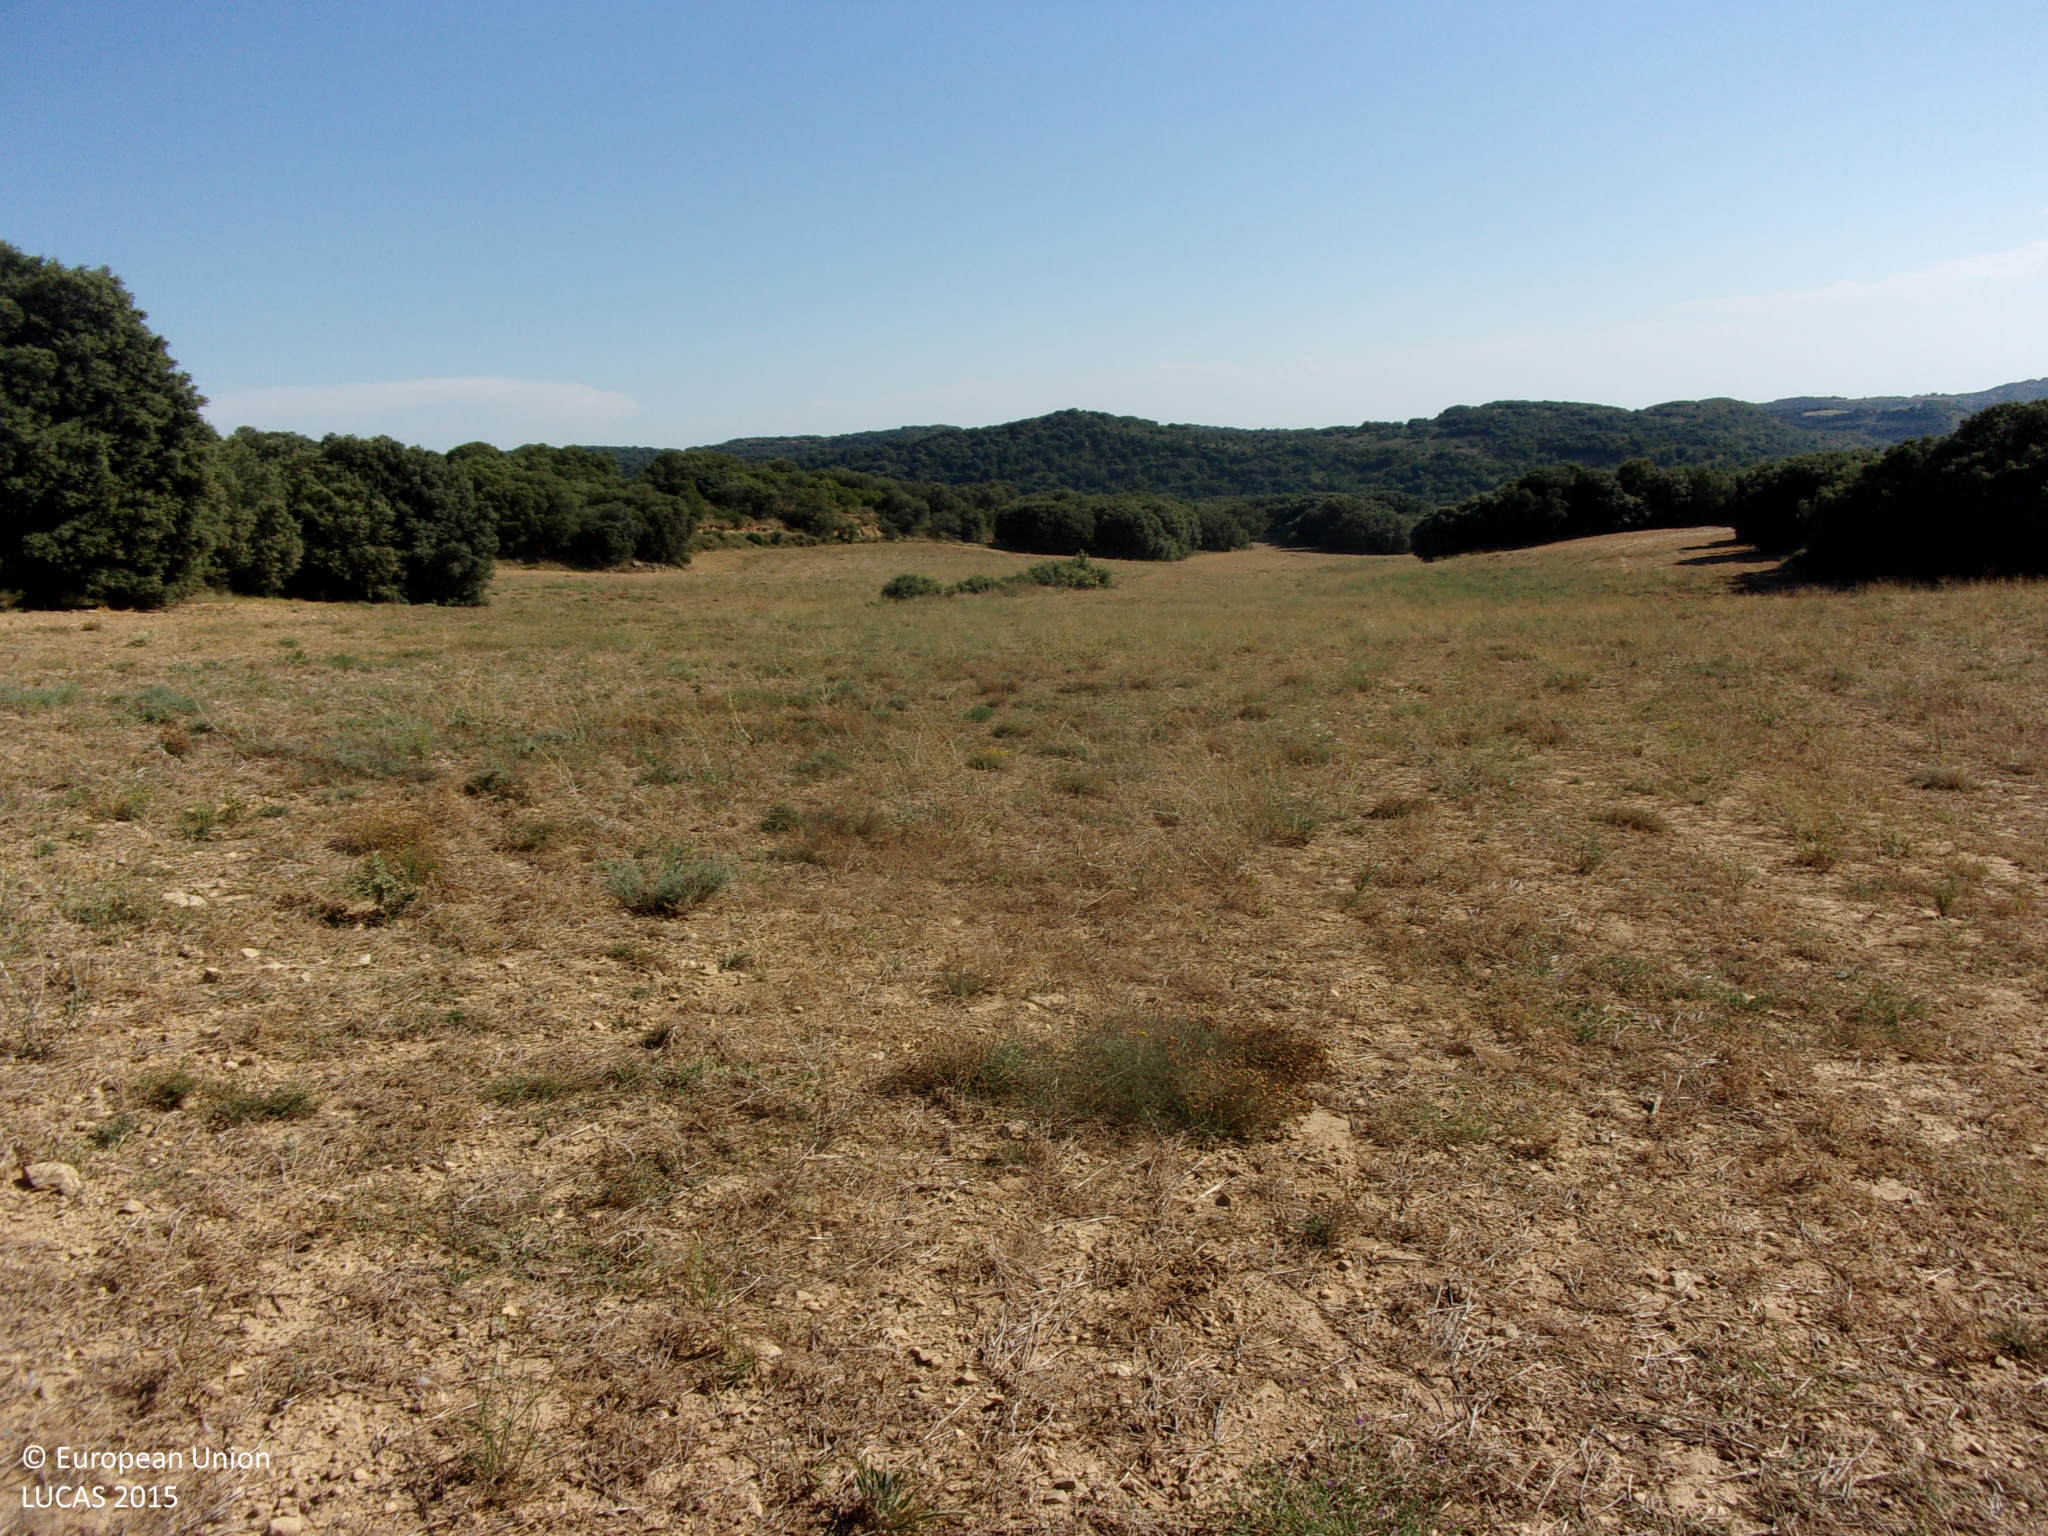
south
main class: Grassland
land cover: Spontaneously vegetated surfaces
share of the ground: 50 - 75 %
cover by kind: herbaceous plants 75 %, unconsolidated bare surface 25 %
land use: Fallow land
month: August
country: ES
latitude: 42.3349
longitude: -1.0861
